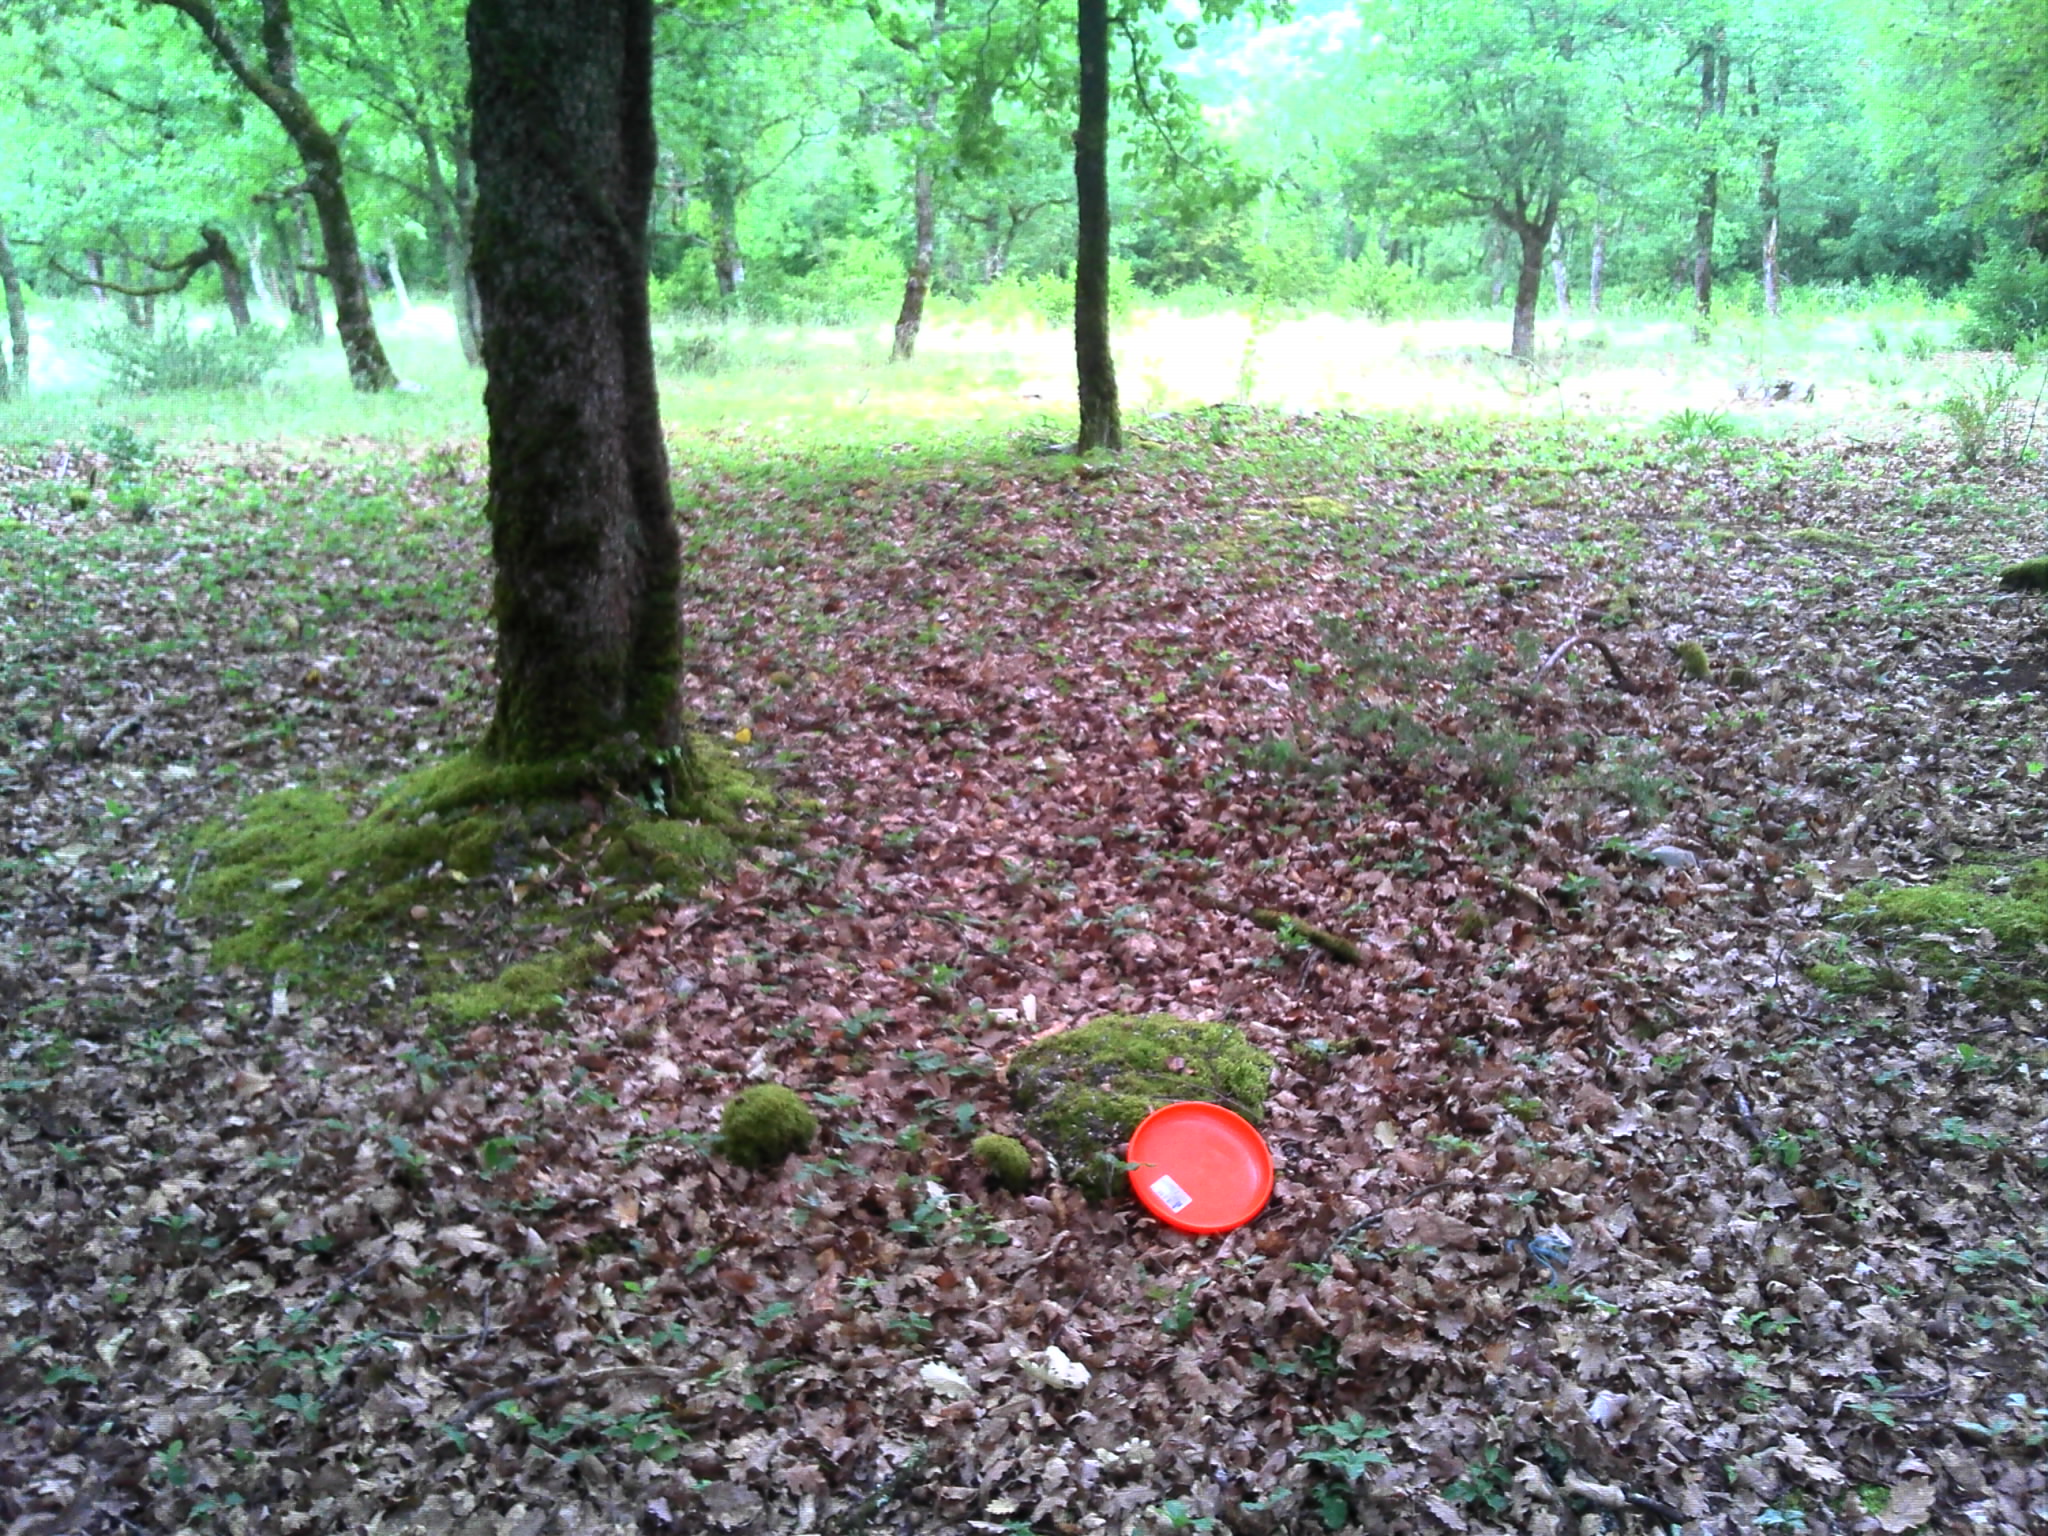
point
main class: Woodland
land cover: Broadleaved woodland
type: acidophilous oak and oak-birch forest
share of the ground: > 75 %
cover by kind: broadleaved forest trees 90 %, herbaceous plants 10 %
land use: Forestry
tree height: > 5 m
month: June
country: FR
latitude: 44.4440
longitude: 1.8202
